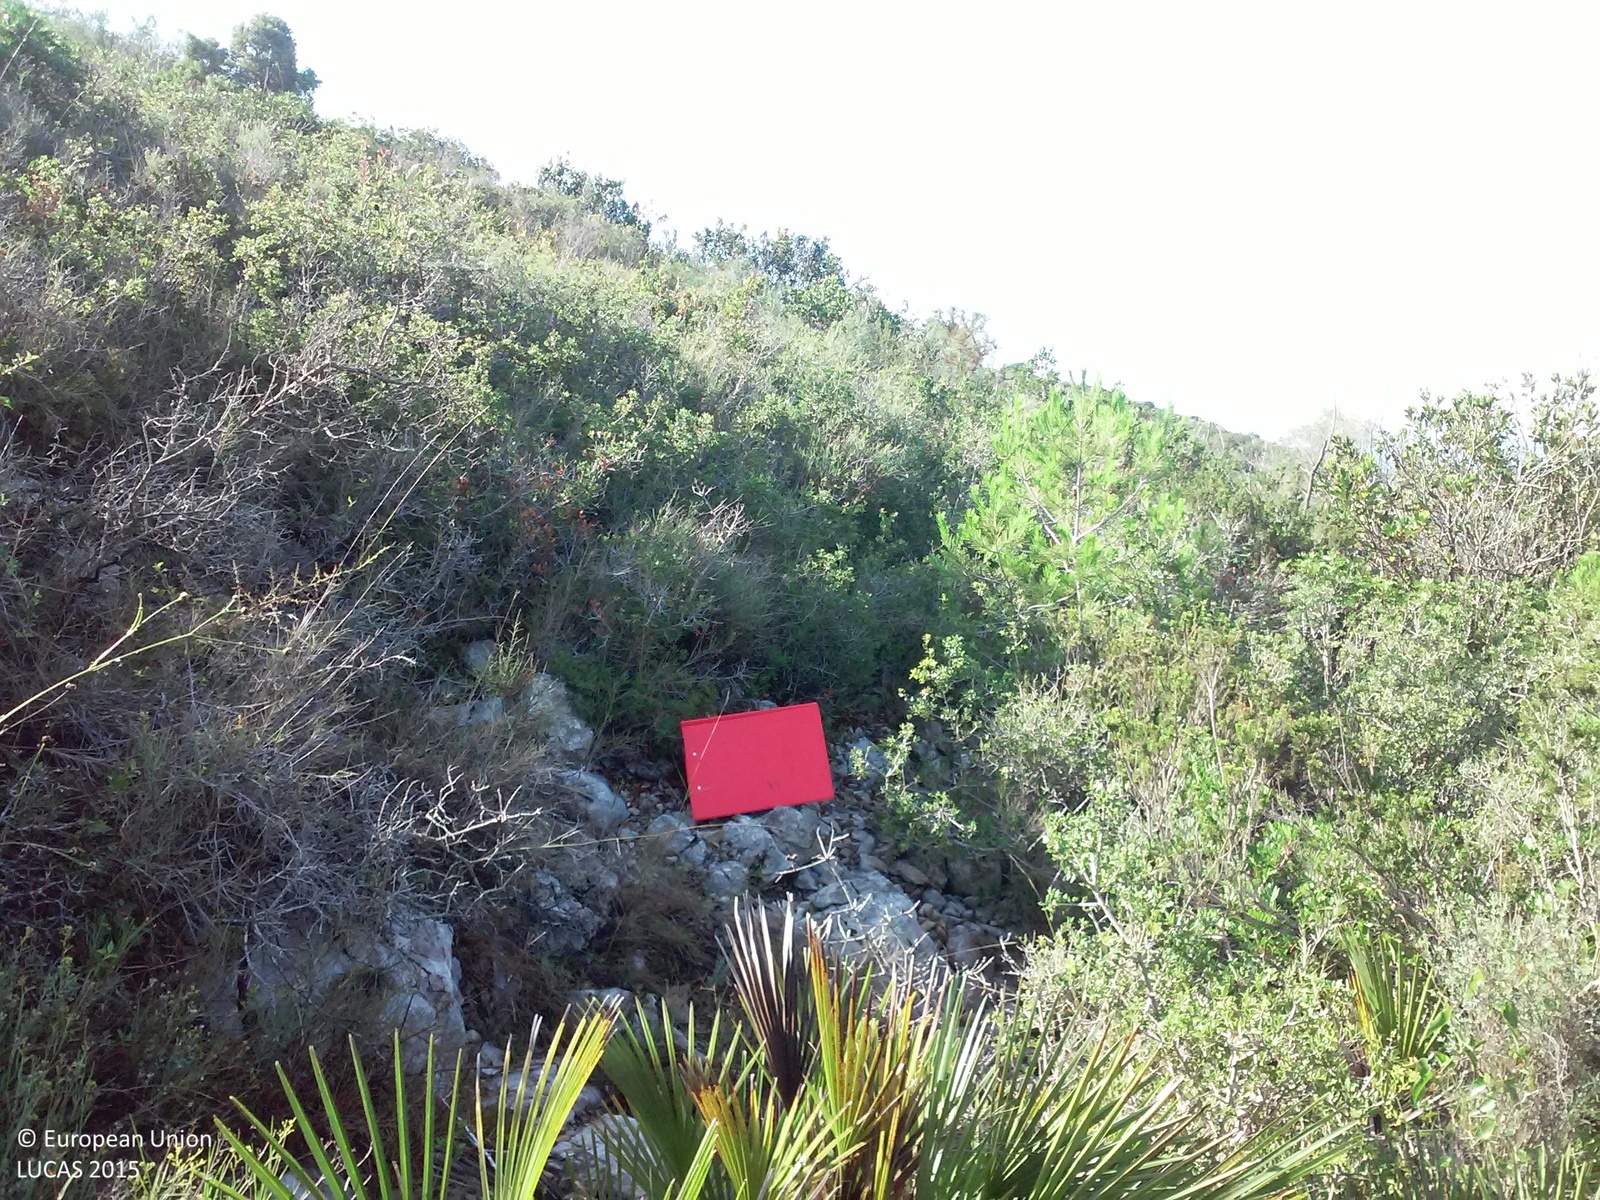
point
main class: Shrubland
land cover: Shrubland with sparse tree cover
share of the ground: 25 - 50 %
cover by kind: shrubs 75 %, herbaceous plants 20 %, broadleaved forest trees 5 %
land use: Semi-natural and natural areas not in use
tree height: < 5 m
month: September
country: ES
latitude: 41.2160
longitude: 1.6092
